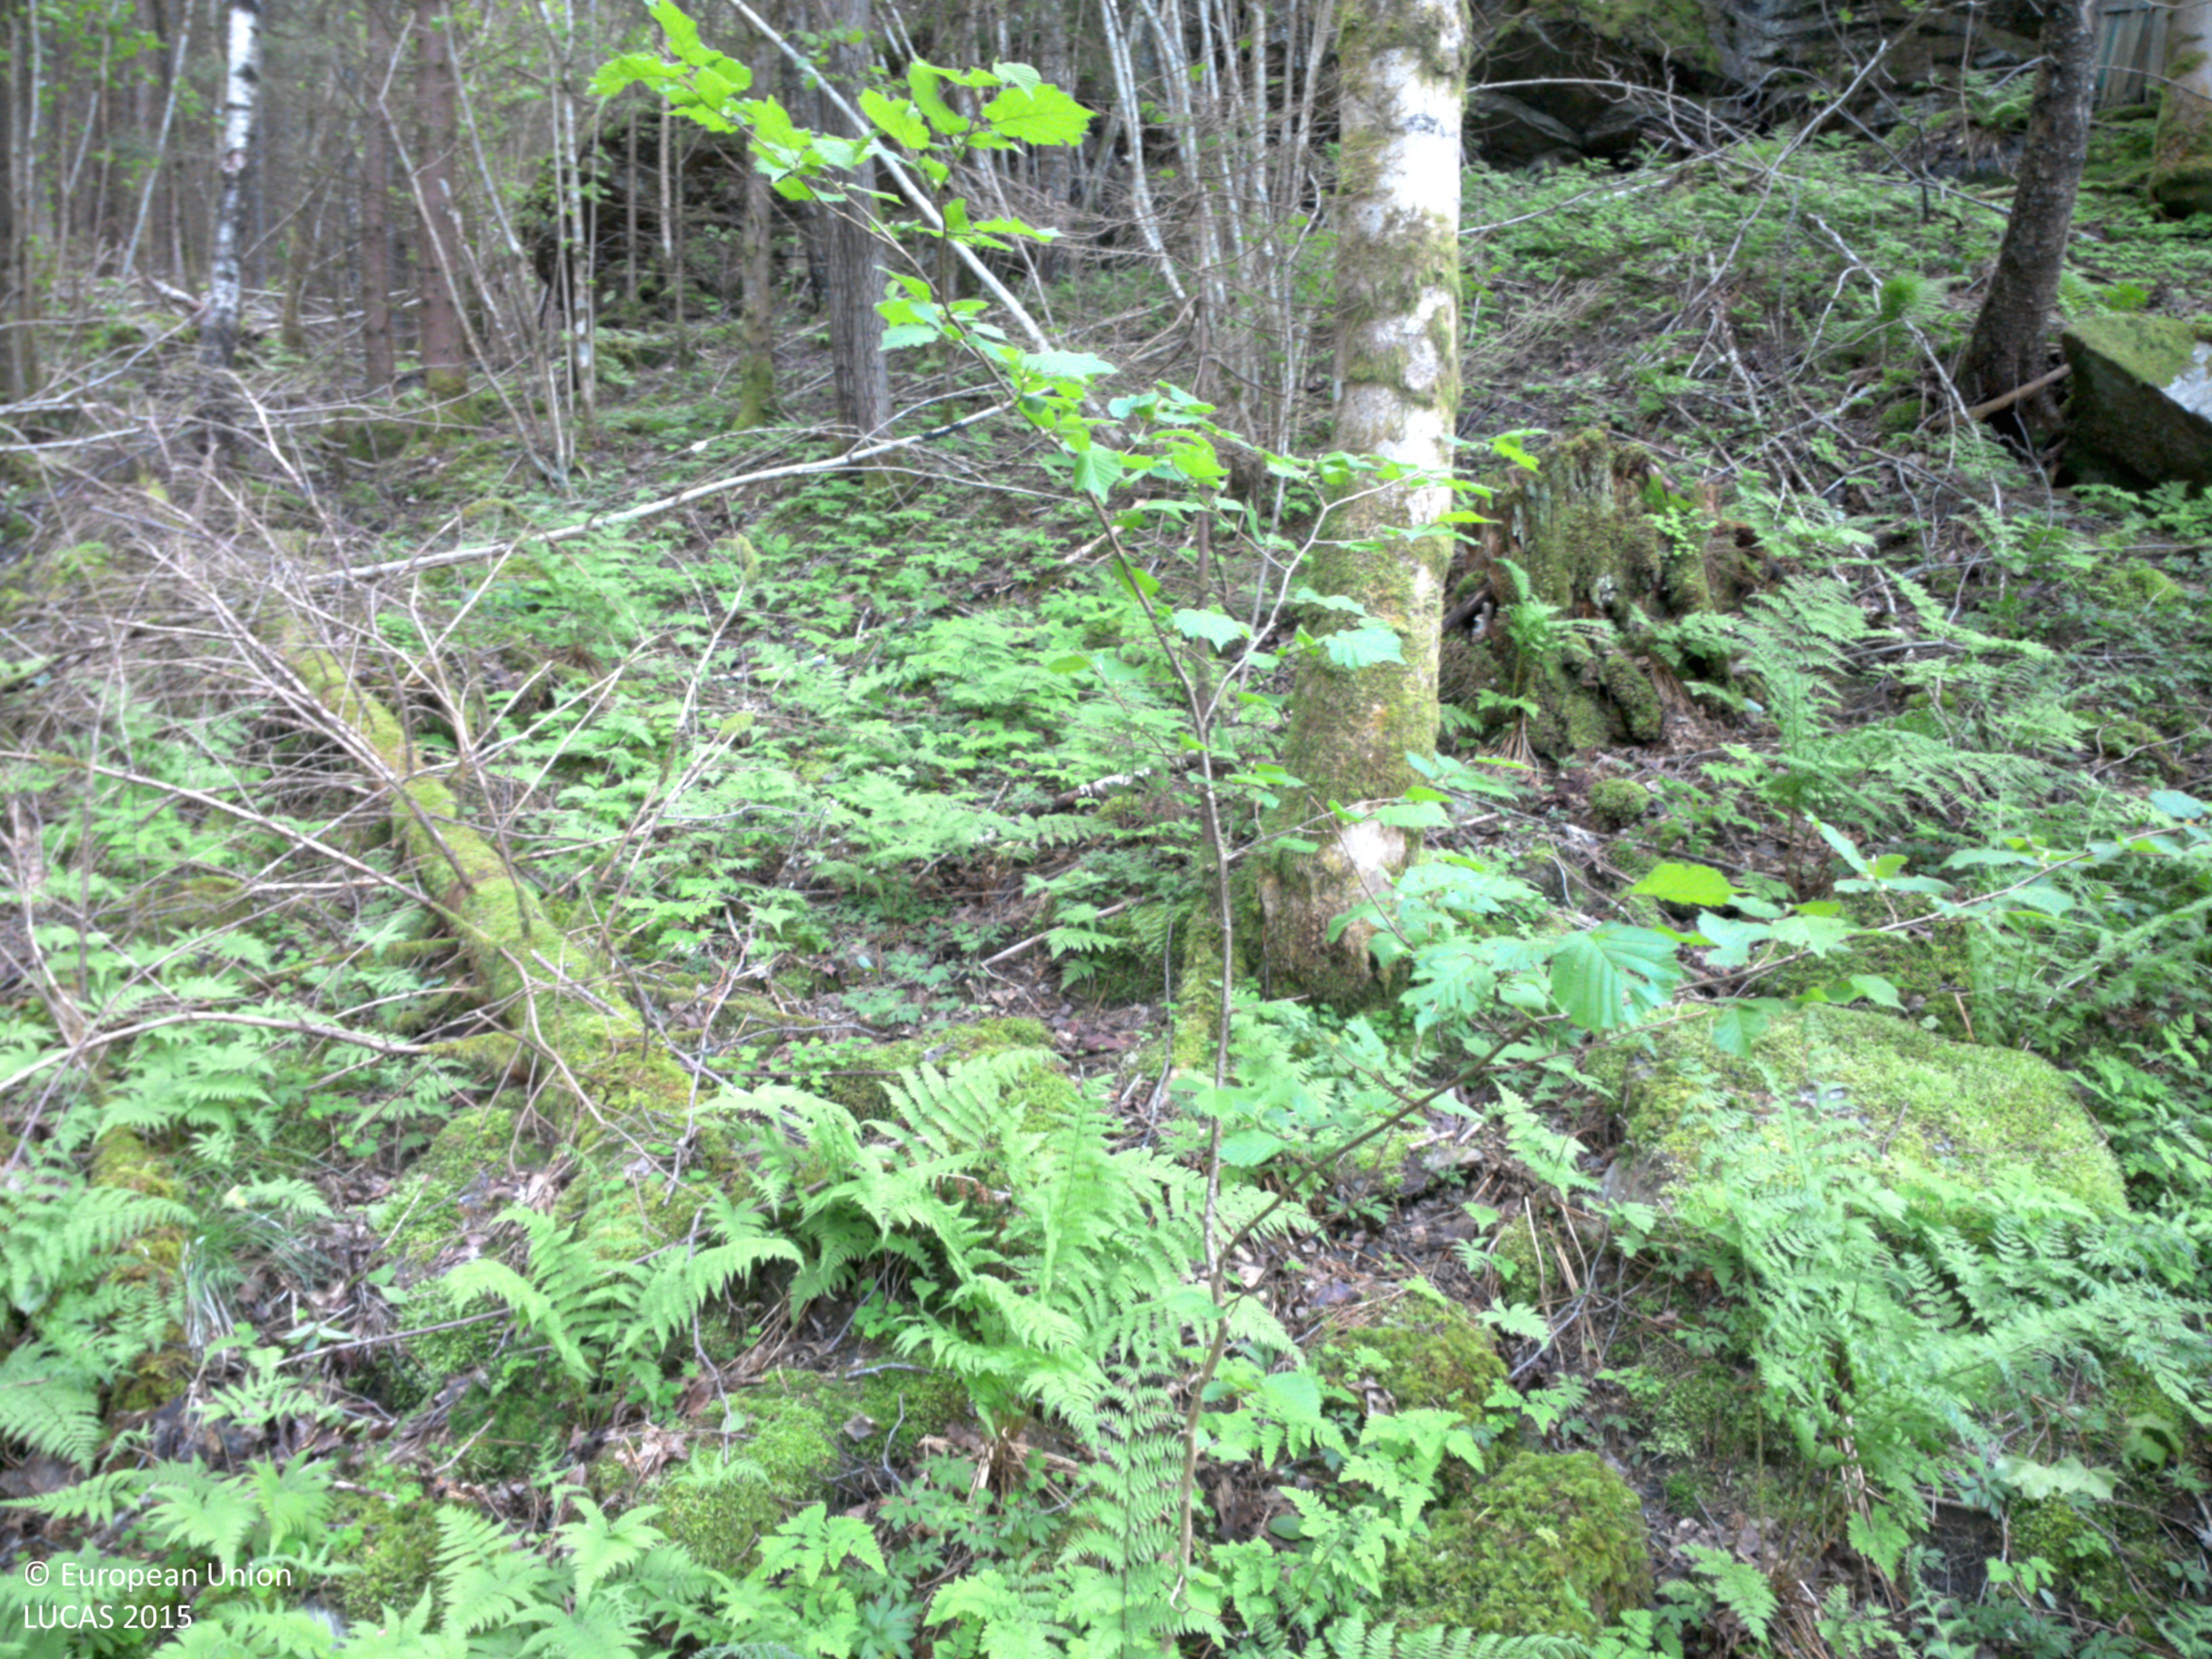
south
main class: Woodland
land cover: Broadleaved woodland
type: mesophytic deciduous forest
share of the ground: 50 - 75 %
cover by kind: broadleaved forest trees 65 %, herbaceous plants 20 %, shrubs 10 %, coniferous forest trees 5 %
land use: Forestry
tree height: > 5 m
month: June
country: SE
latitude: 58.1878
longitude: 11.9183
